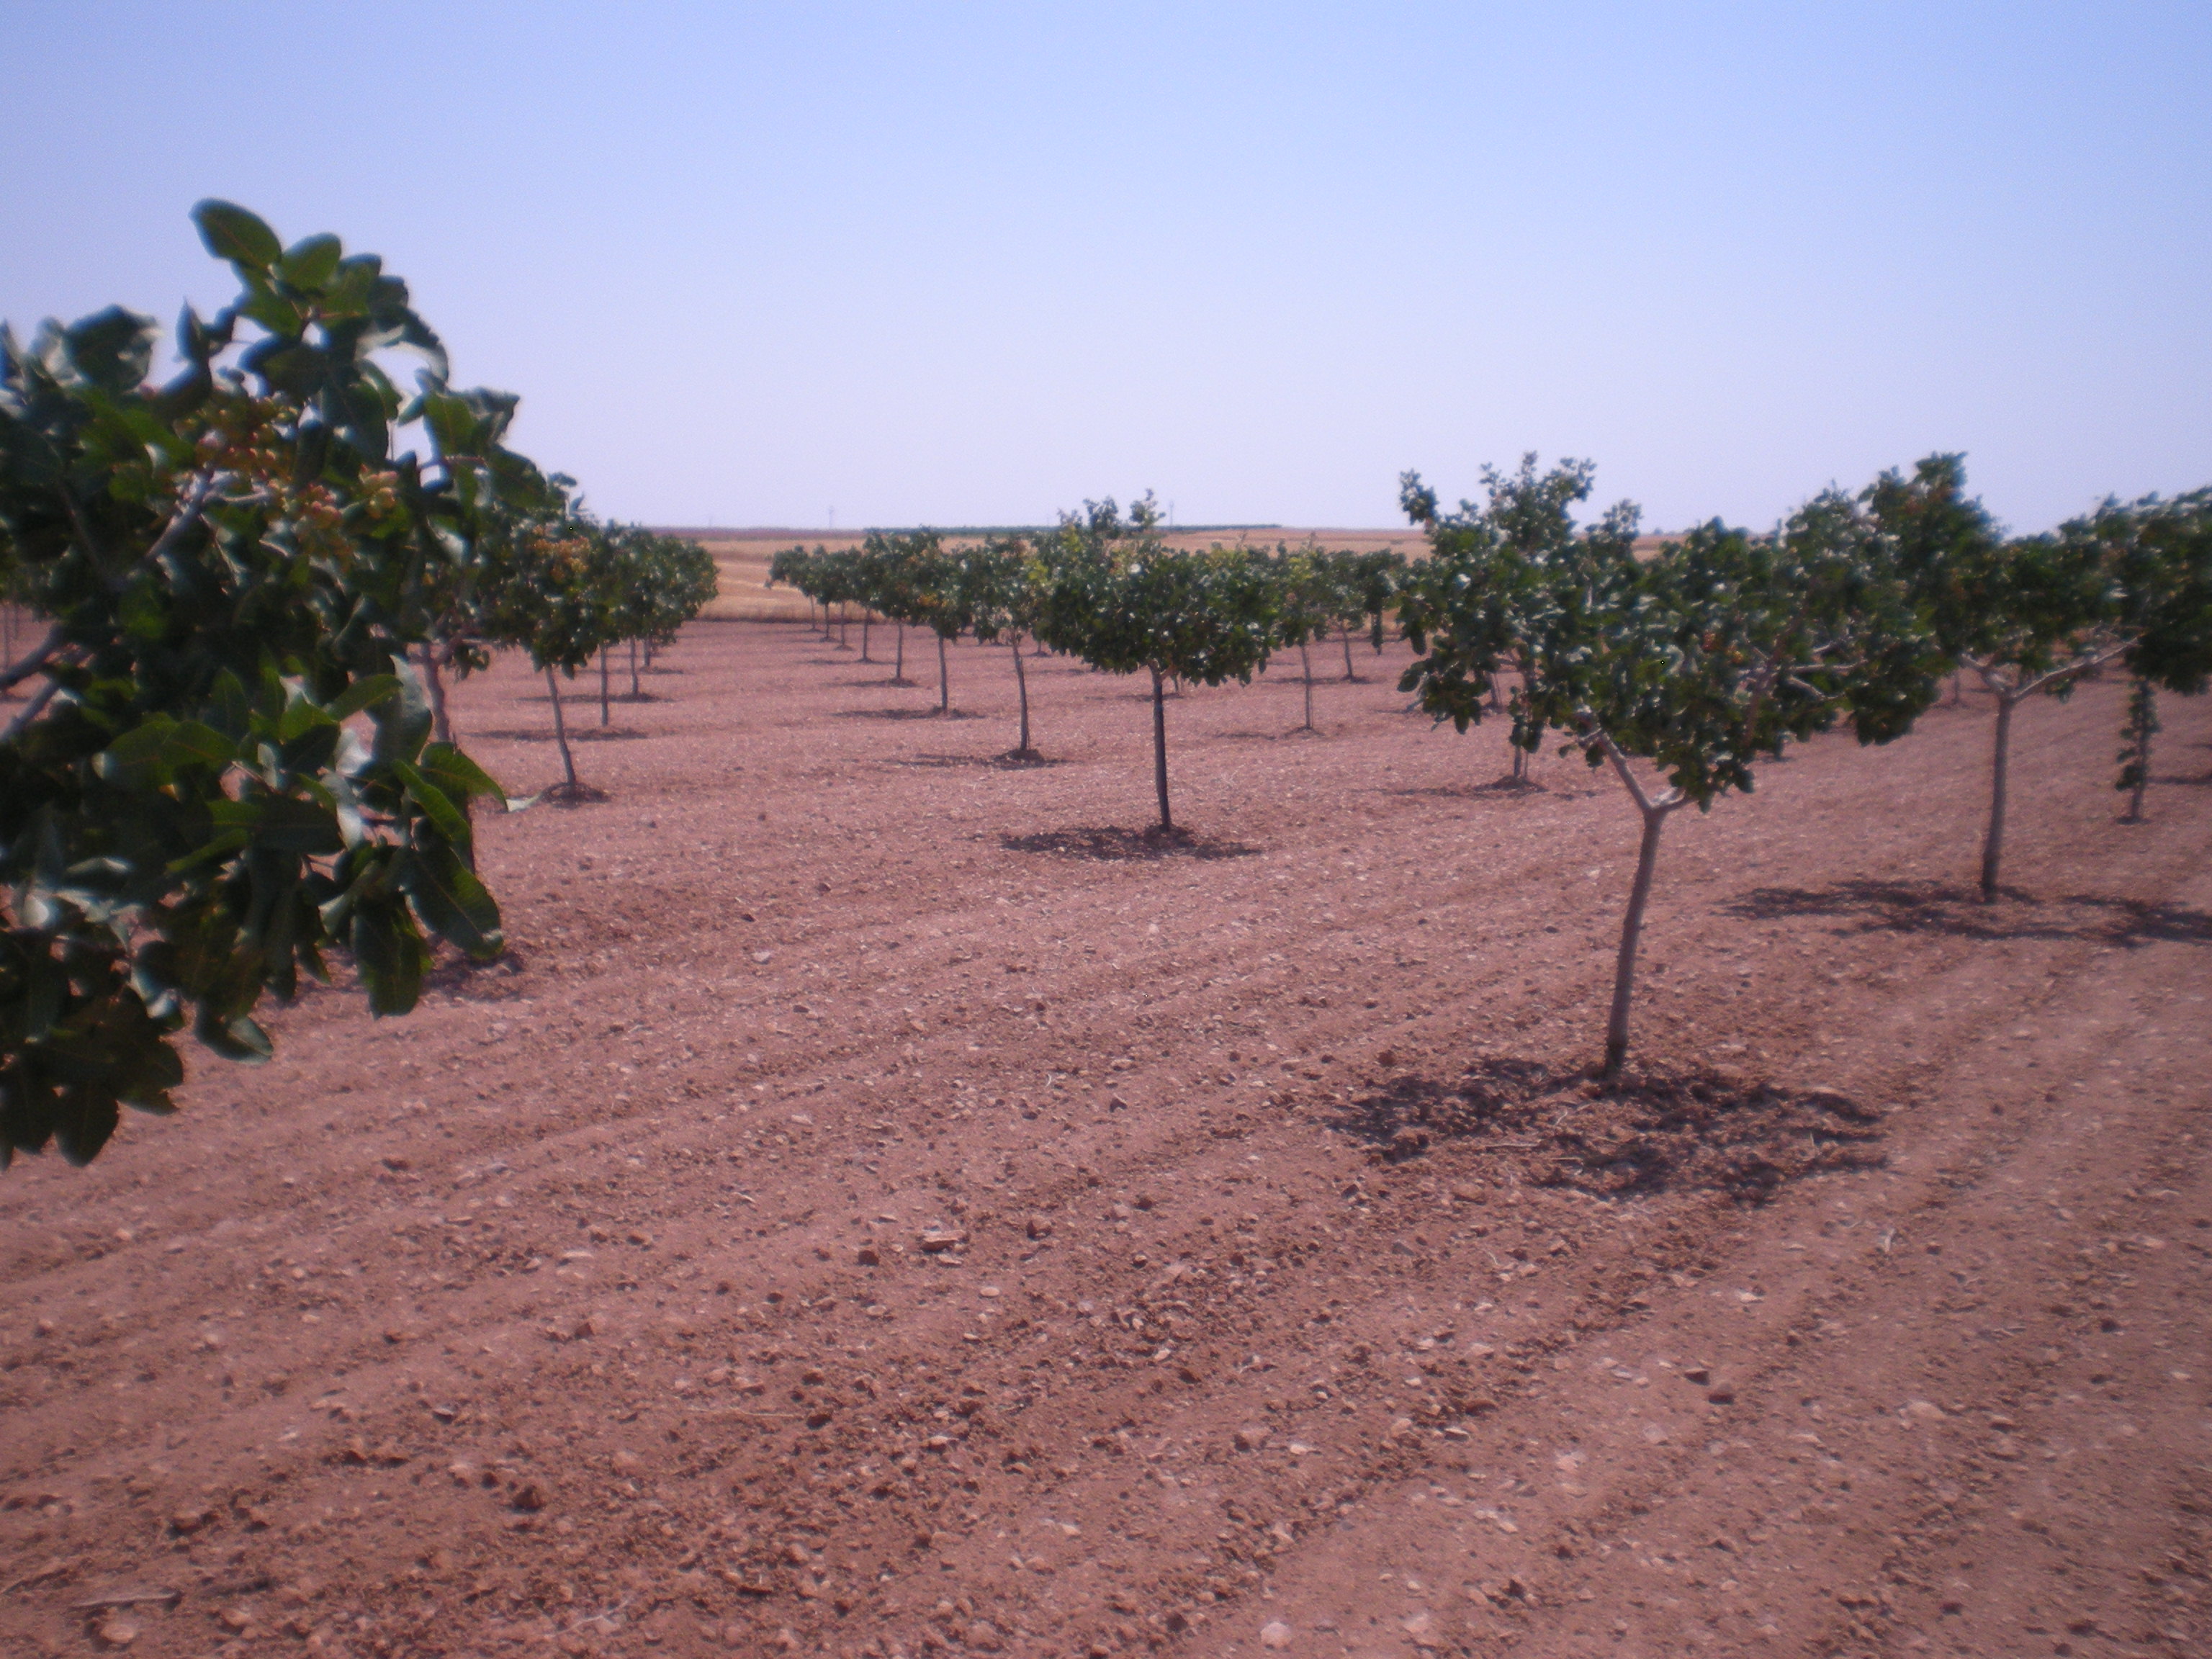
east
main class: Cropland
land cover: Nuts trees
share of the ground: < 10 %
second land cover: Other bare soil
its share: > 75 %
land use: Agriculture (excluding fallow land and kitchen gardens)
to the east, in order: Nuts trees; Other bare soil; Grass margins; Barley; Grass margins; Barley; Grass margins; Barley
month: June
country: ES
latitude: 39.5816
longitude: -3.3999
